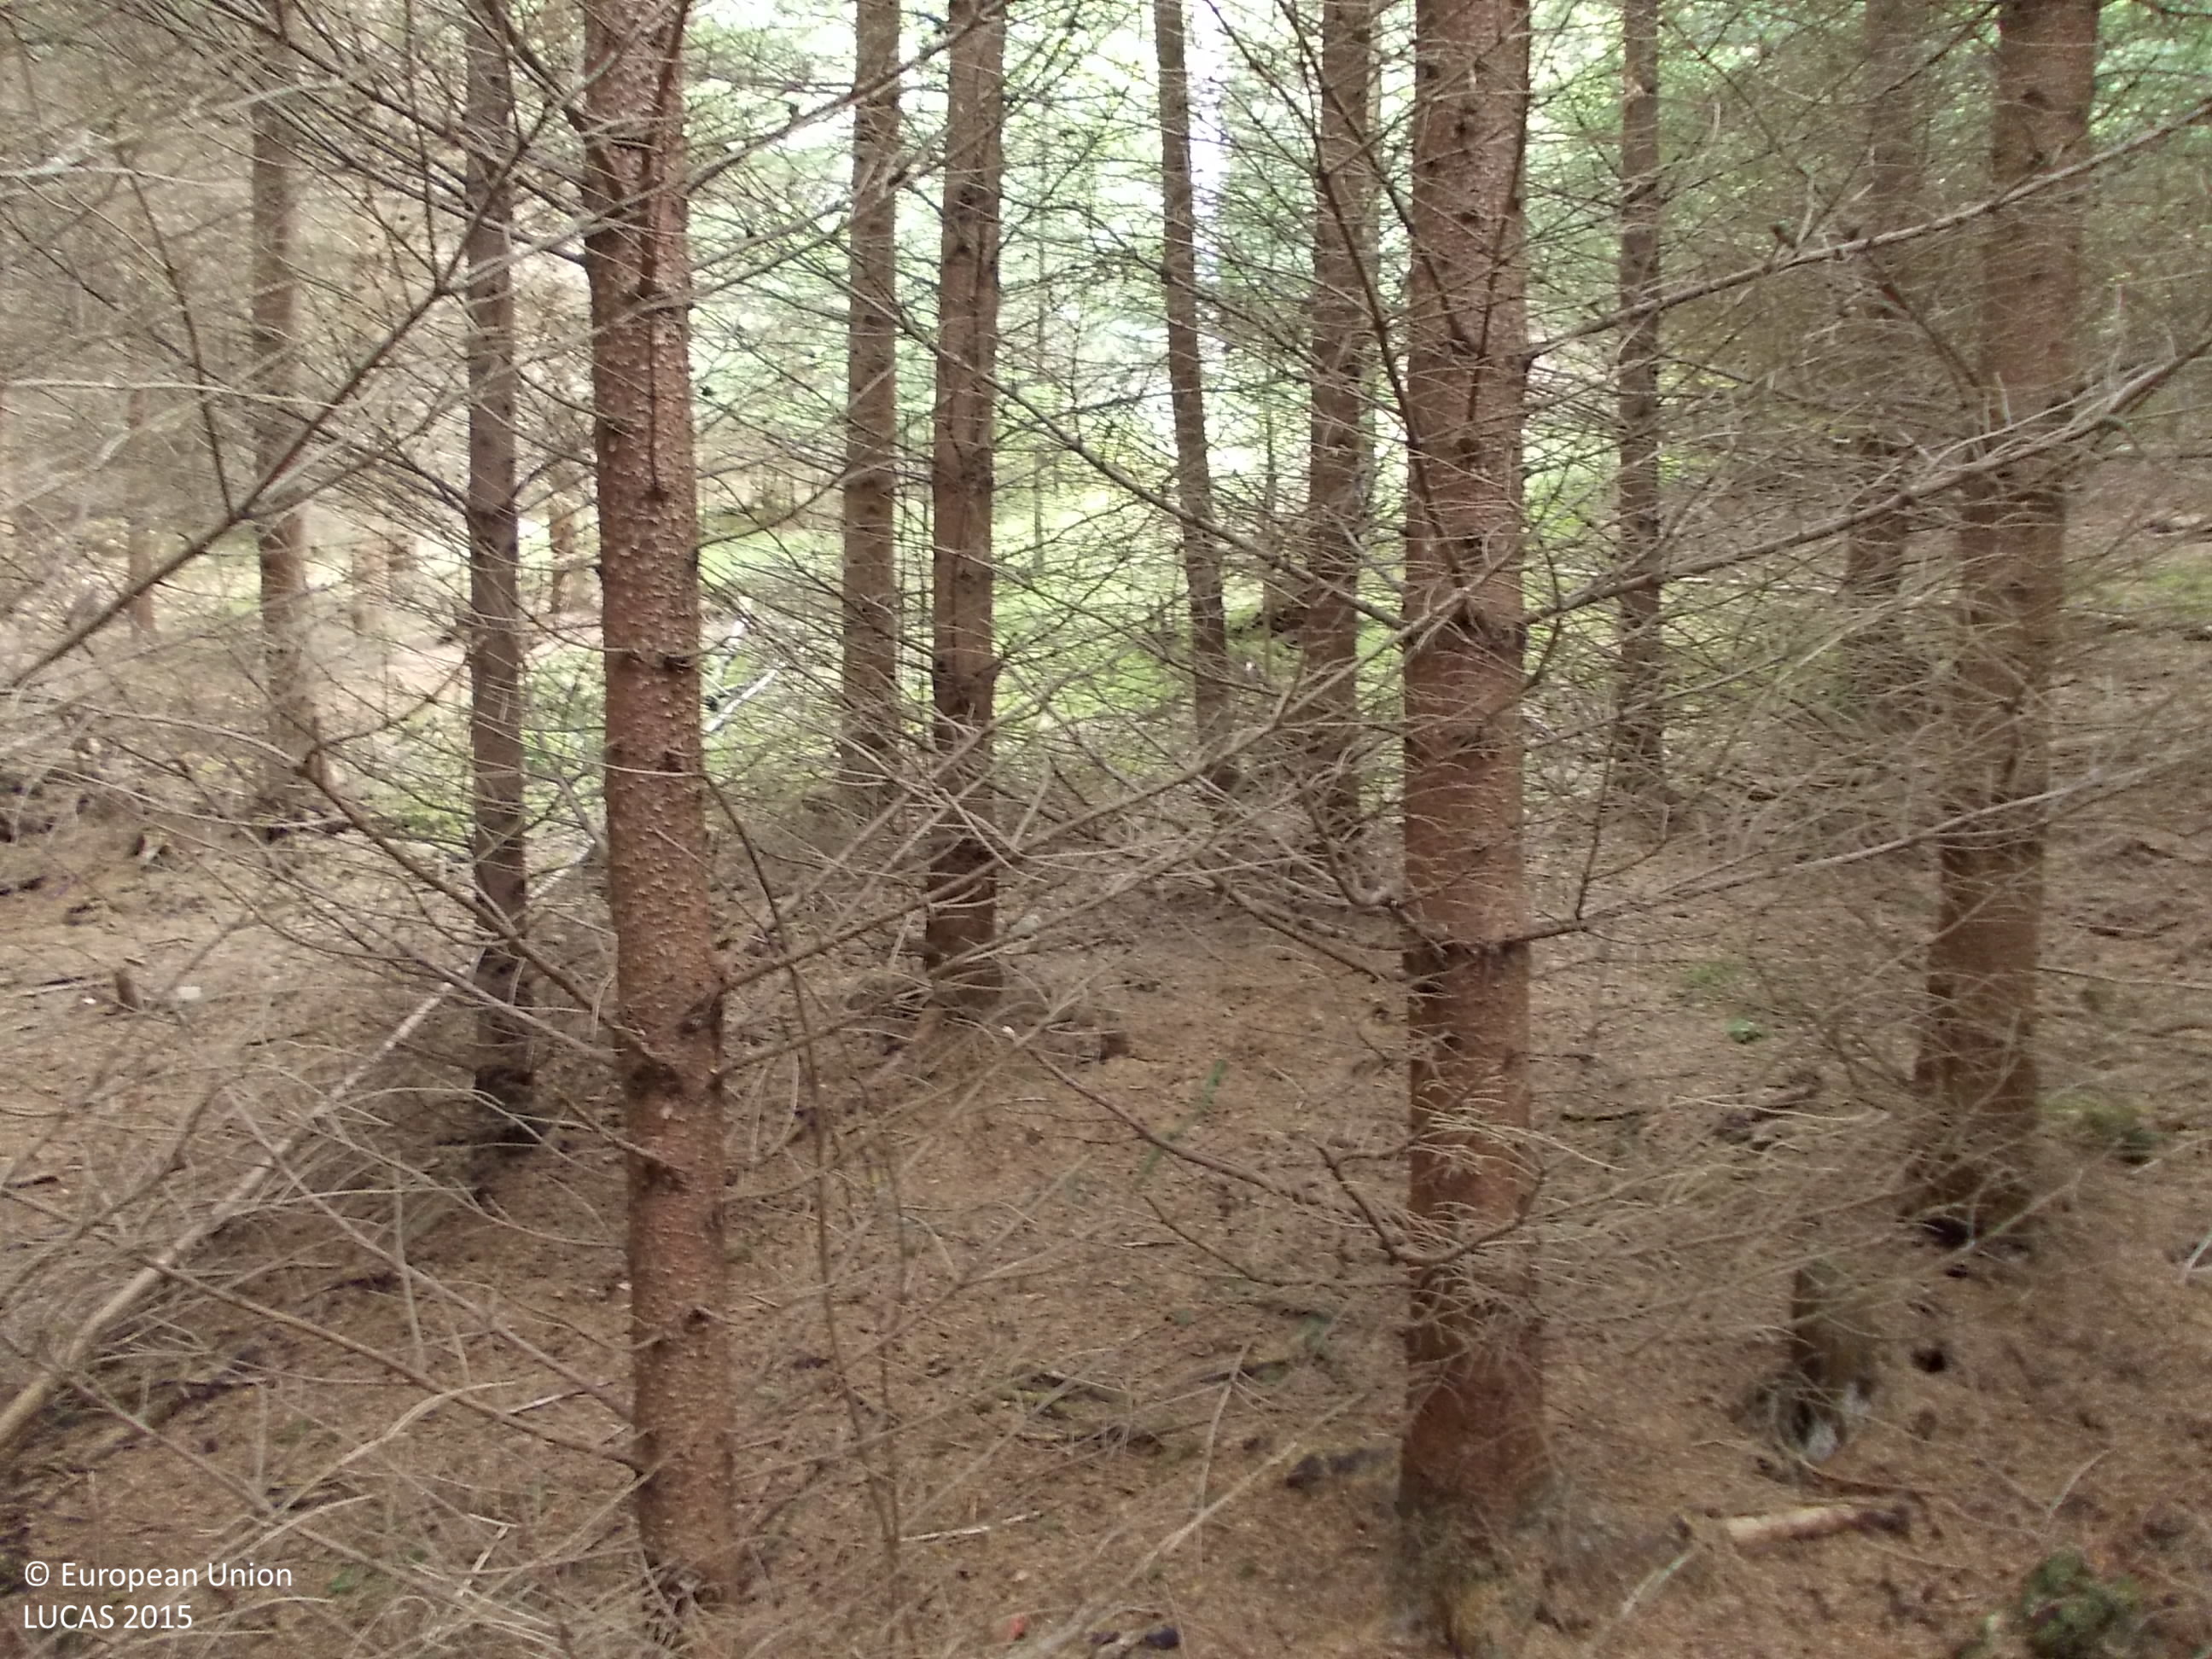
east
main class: Woodland
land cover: Spruce dominated coniferous woodland
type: hemiboreal forest and nemoral coniferous forest and mixed broadleaved-coniferous forest
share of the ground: > 75 %
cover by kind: coniferous forest trees 100 %
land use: Forestry
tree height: > 5 m
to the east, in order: Spruce dominated coniferous woodland; Tracks; Spruce dominated coniferous woodland; Tracks; Spruce dominated coniferous woodland; Tracks
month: May
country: CZ
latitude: 49.2395
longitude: 13.7774
